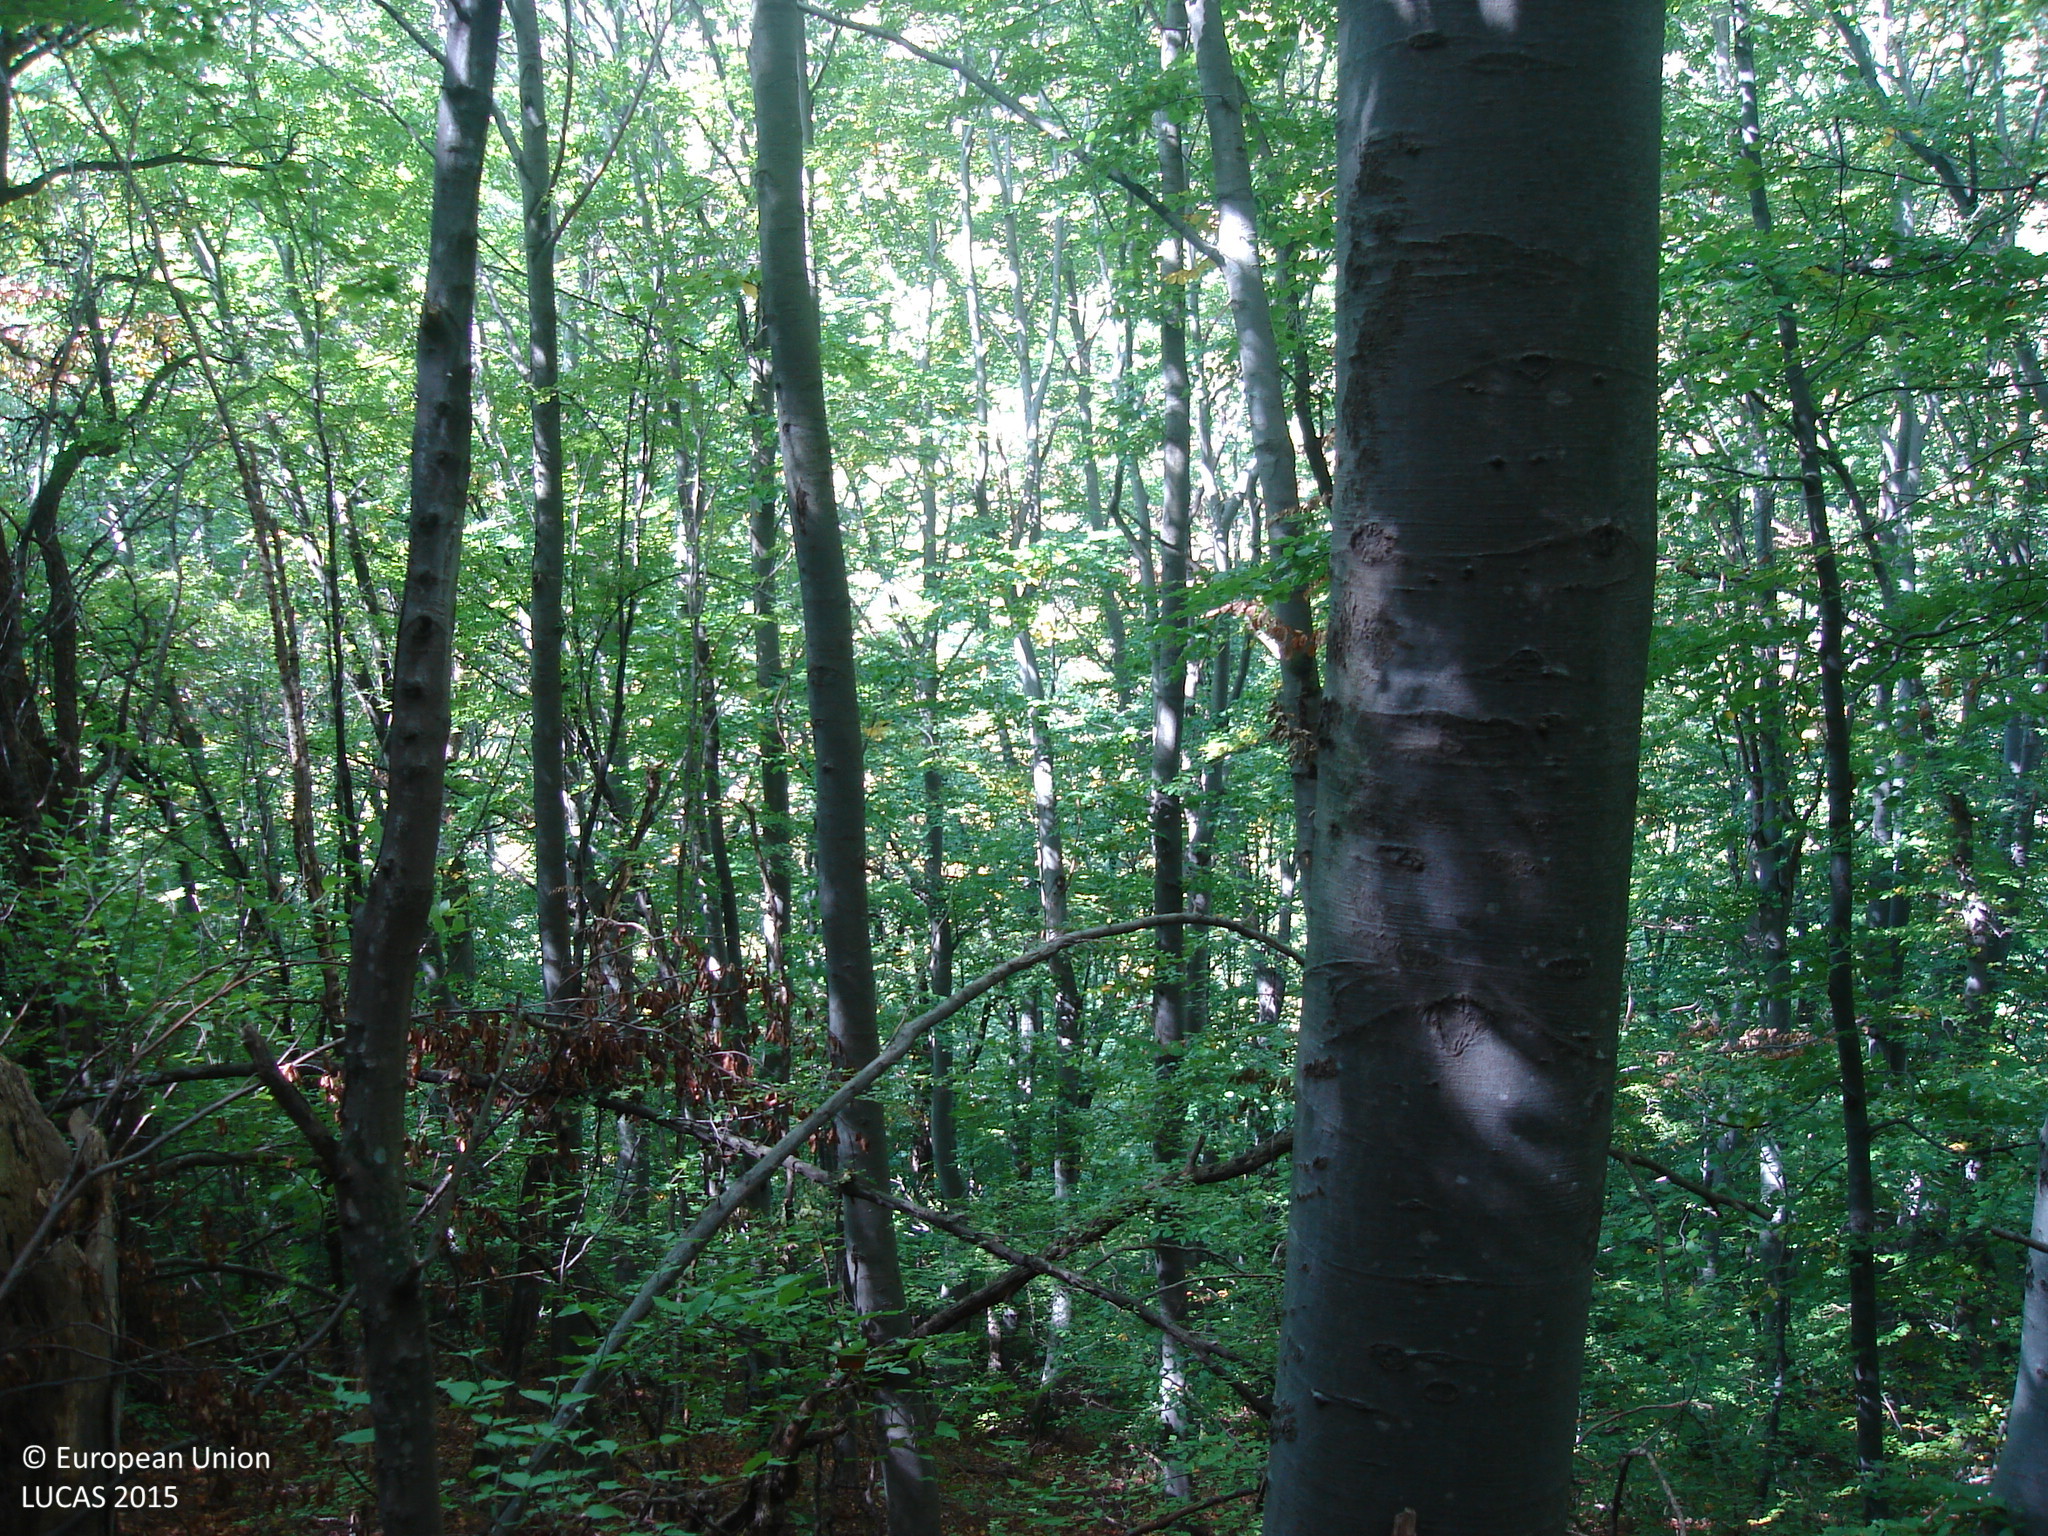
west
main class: Woodland
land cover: Broadleaved woodland
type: beech forest
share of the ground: 50 - 75 %
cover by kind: broadleaved forest trees 70 %, consolidated bare surface 20 %, herbaceous plants 5 %, lichens and mosses 5 %
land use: Forestry
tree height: > 5 m
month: October
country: BG
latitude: 43.0201
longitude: 23.4014
